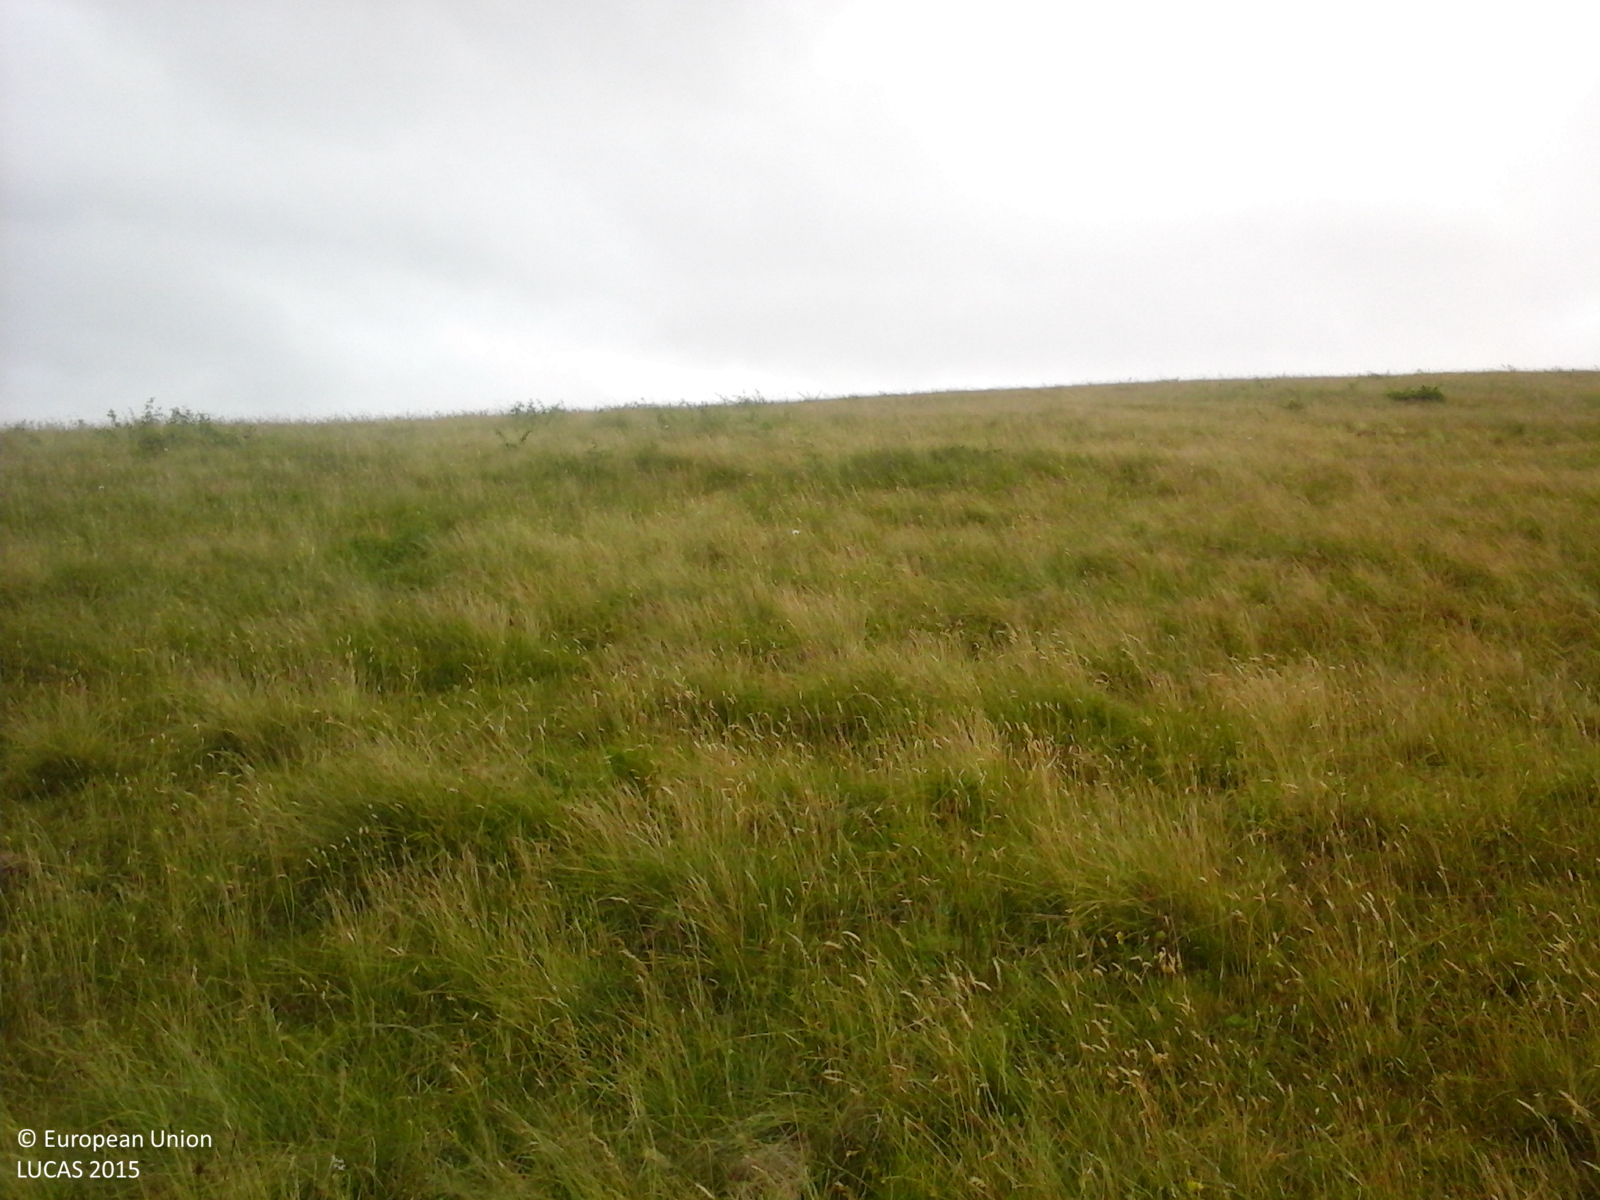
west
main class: Grassland
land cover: Grassland without tree/shrub cover
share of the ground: > 75 %
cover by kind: herbaceous plants 100 %
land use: Agriculture (excluding fallow land and kitchen gardens)
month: June
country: RO
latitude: 47.0917
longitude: 26.2975
